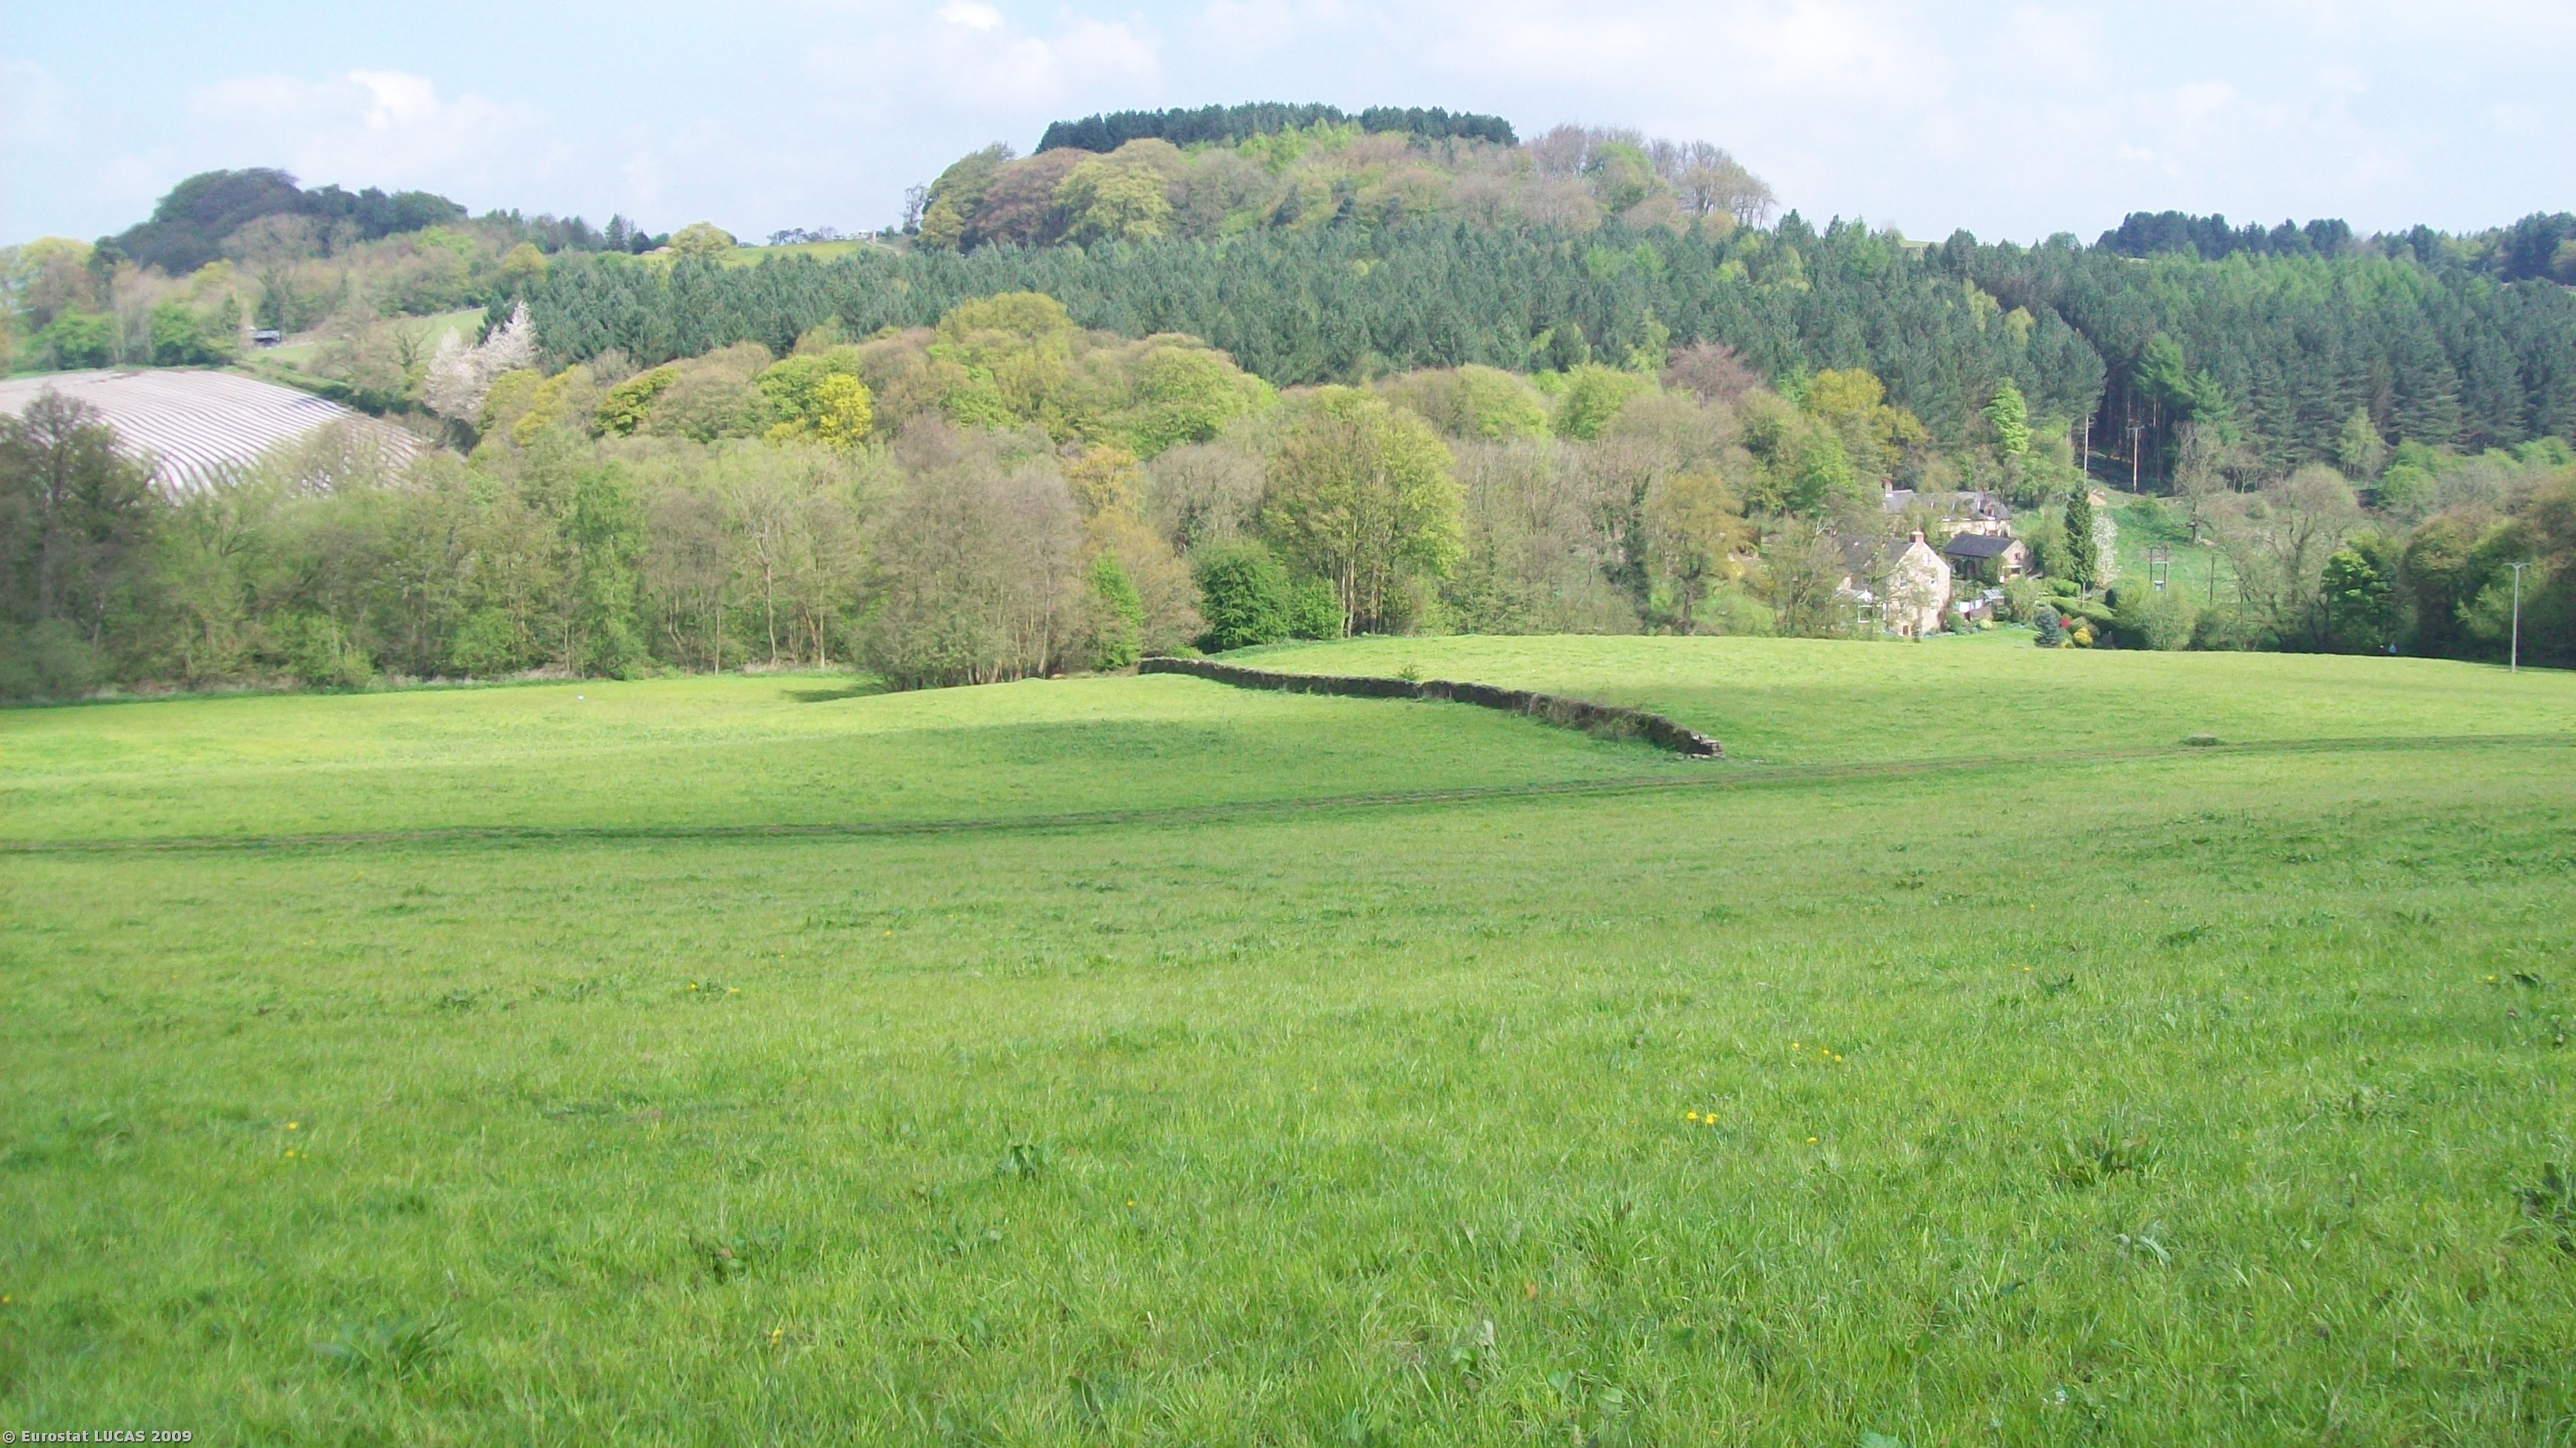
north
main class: Grassland
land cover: Grassland without tree/shrub cover
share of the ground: > 75 %
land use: Agriculture (excluding fallow land and kitchen gardens)
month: April
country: GB
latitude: 53.0851
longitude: -1.5321
